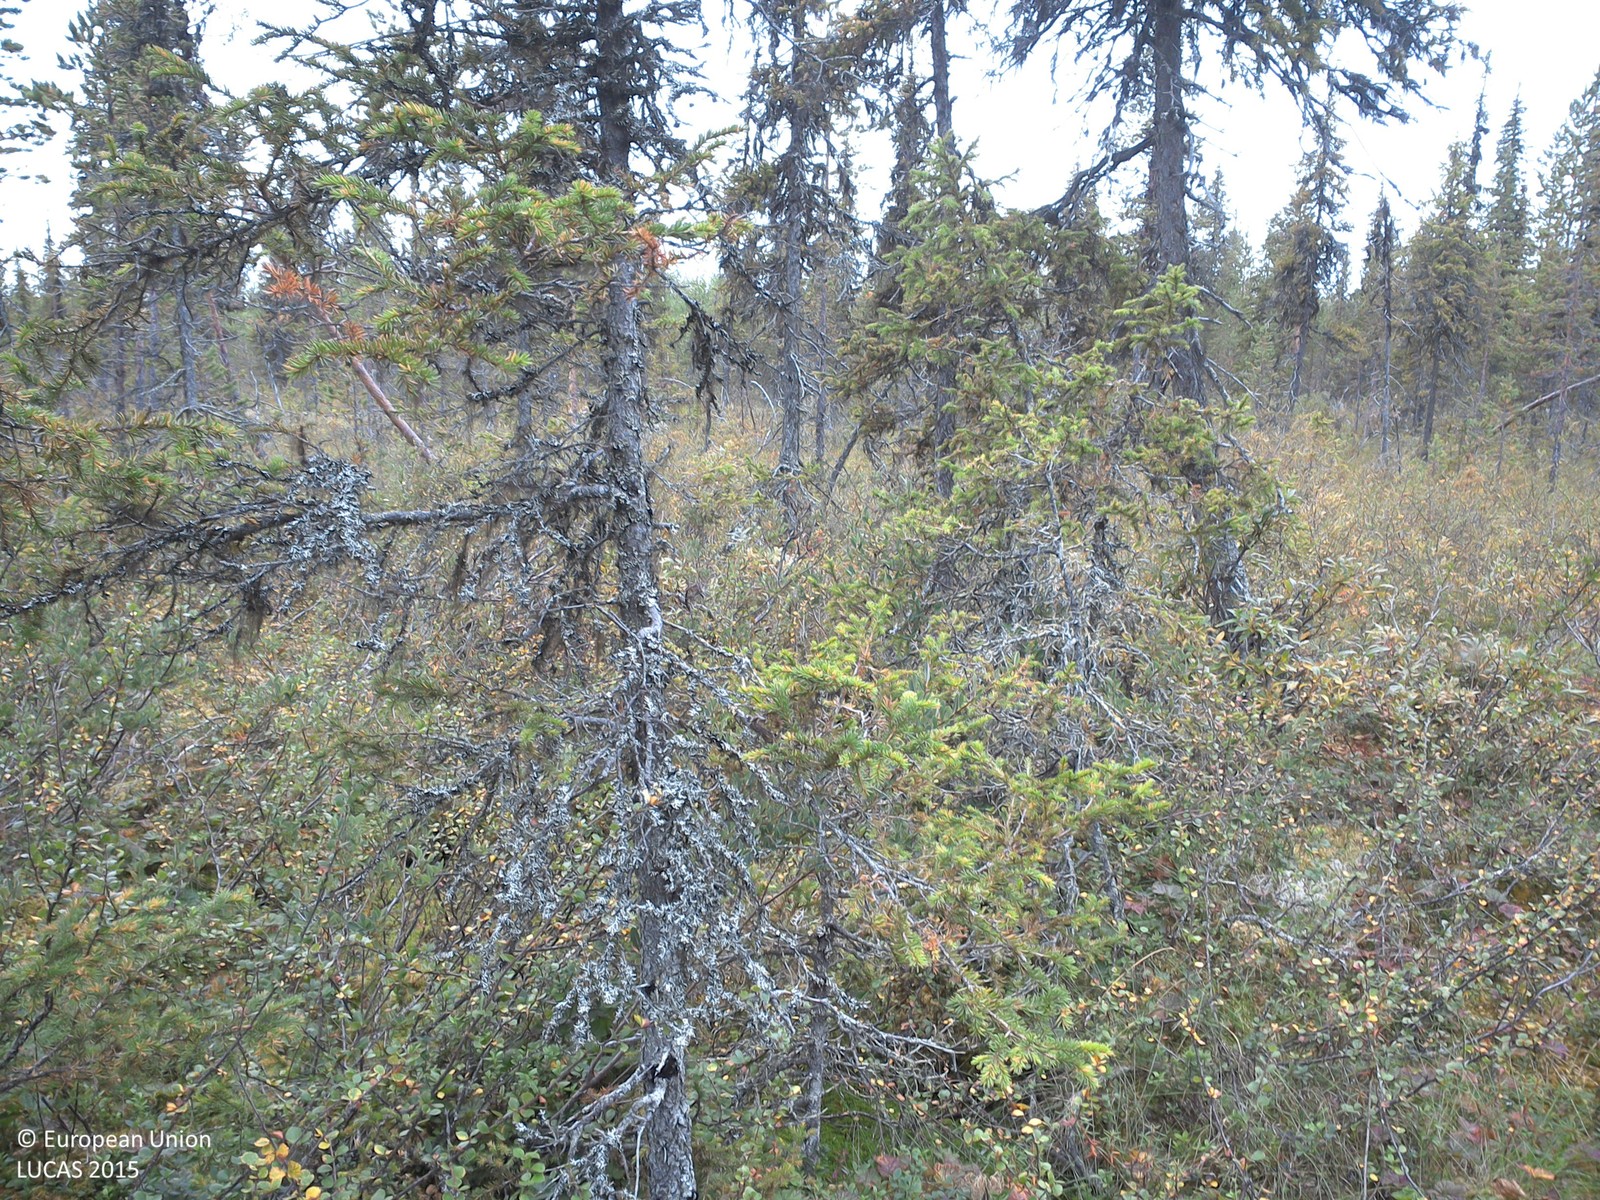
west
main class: Woodland
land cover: Spruce dominated coniferous woodland
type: boreal forest
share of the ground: 10 - 25 %
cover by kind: shrubs 60 %, coniferous forest trees 20 %, lichens and mosses 20 %
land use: Forestry
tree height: > 5 m
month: August
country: SE
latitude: 67.8295
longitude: 21.4618
